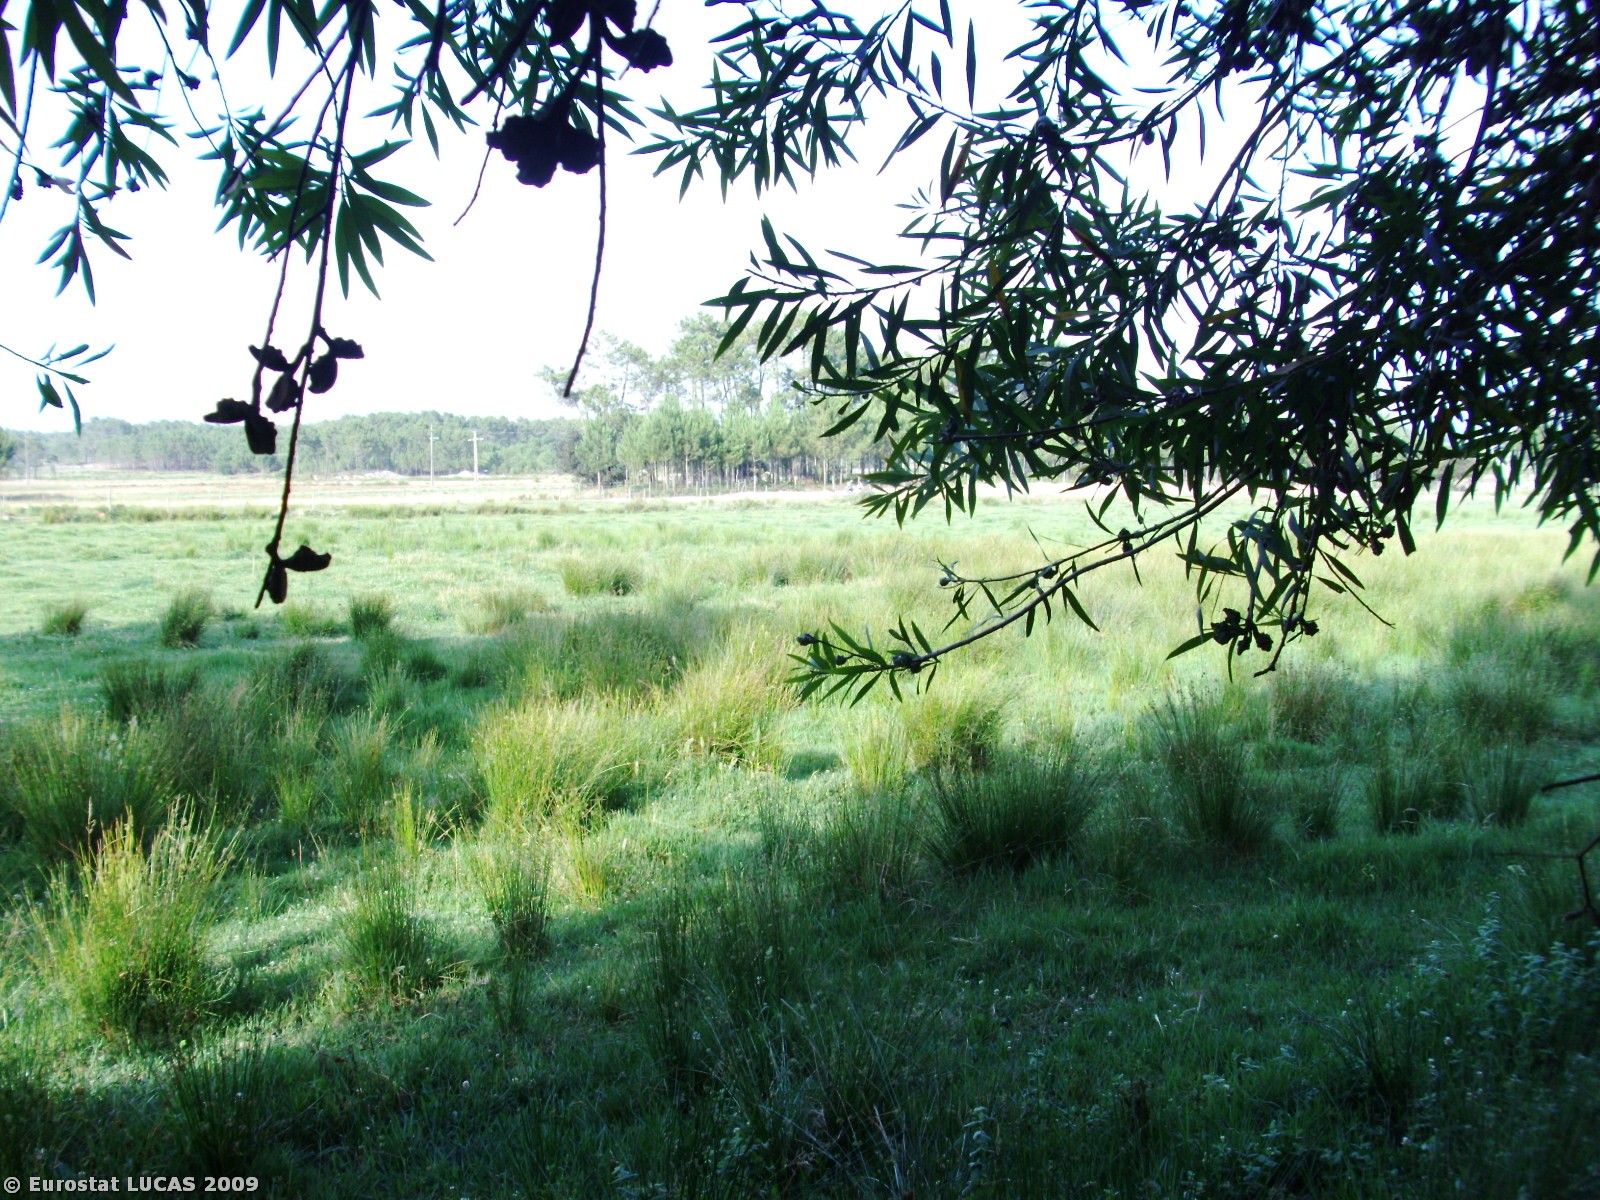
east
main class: Grassland
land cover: Grassland with sparse tree/shrub cover
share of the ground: > 75 %
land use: Agriculture (excluding fallow land and kitchen gardens)
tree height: > 5 m
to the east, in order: Grassland with sparse tree/shrub cover; Fences; Tracks; Grassland without tree/shrub cover; Fences; Bare land; Coniferous woodland; Tracks; Grassland without tree/shrub cover
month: June
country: PT
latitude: 37.3762
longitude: -8.7947
